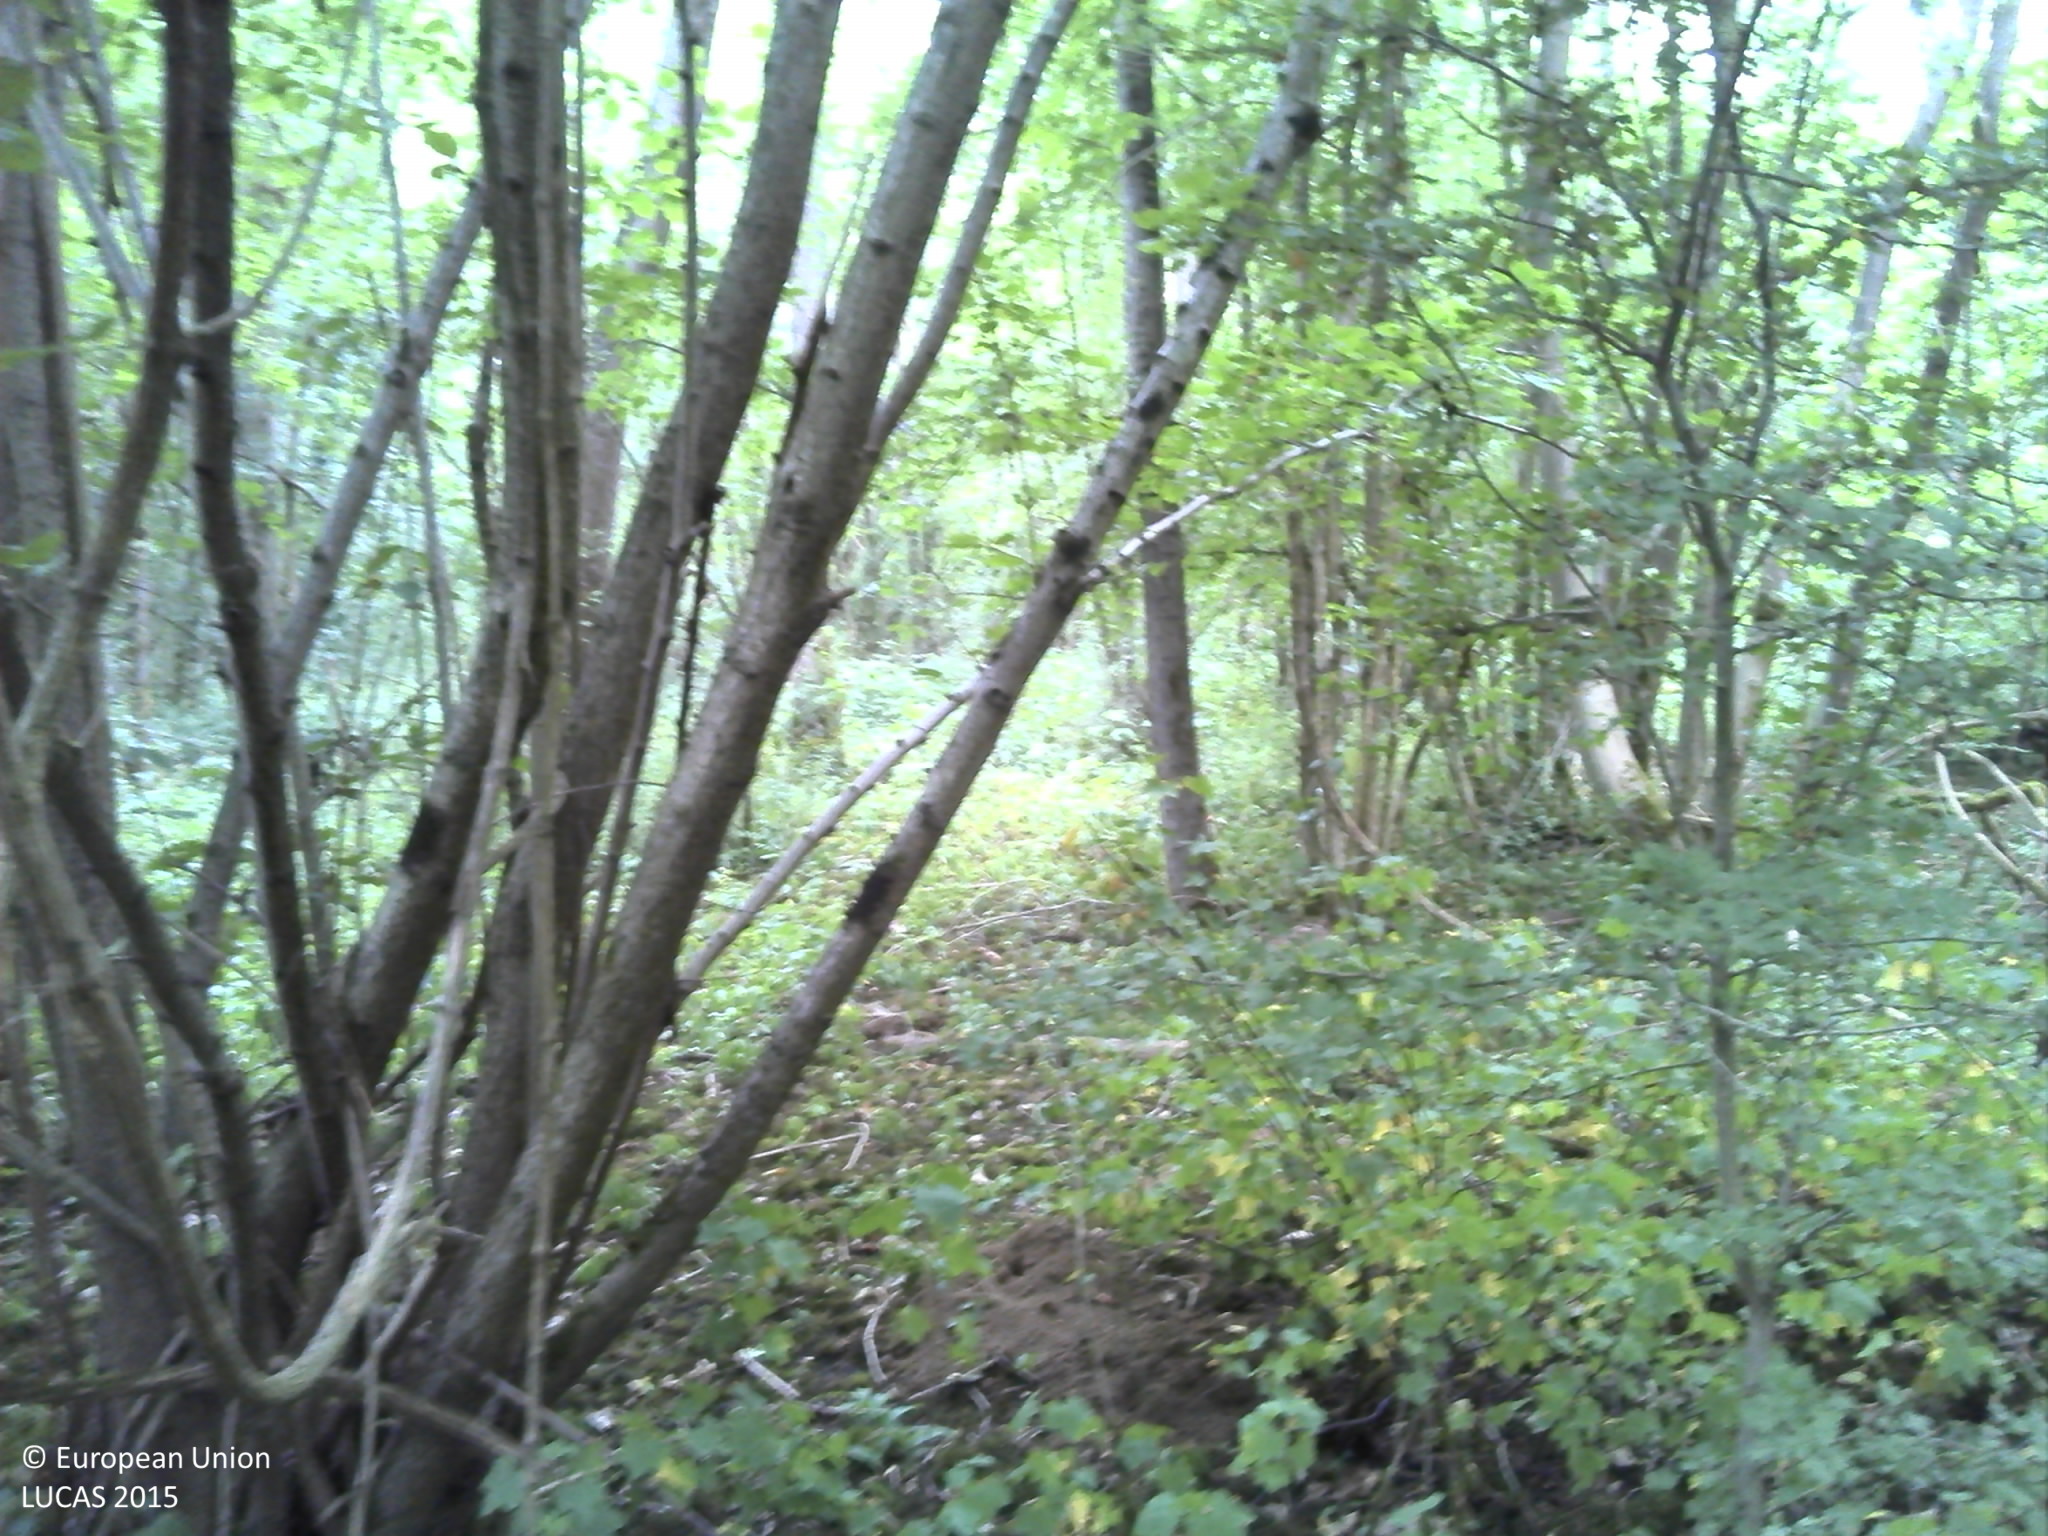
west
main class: Woodland
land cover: Broadleaved woodland
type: floodplain forest
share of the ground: > 75 %
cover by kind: broadleaved forest trees 90 %, herbaceous plants 10 %
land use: Forestry
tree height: > 5 m
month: July
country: FR
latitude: 48.5799
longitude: 2.4660
